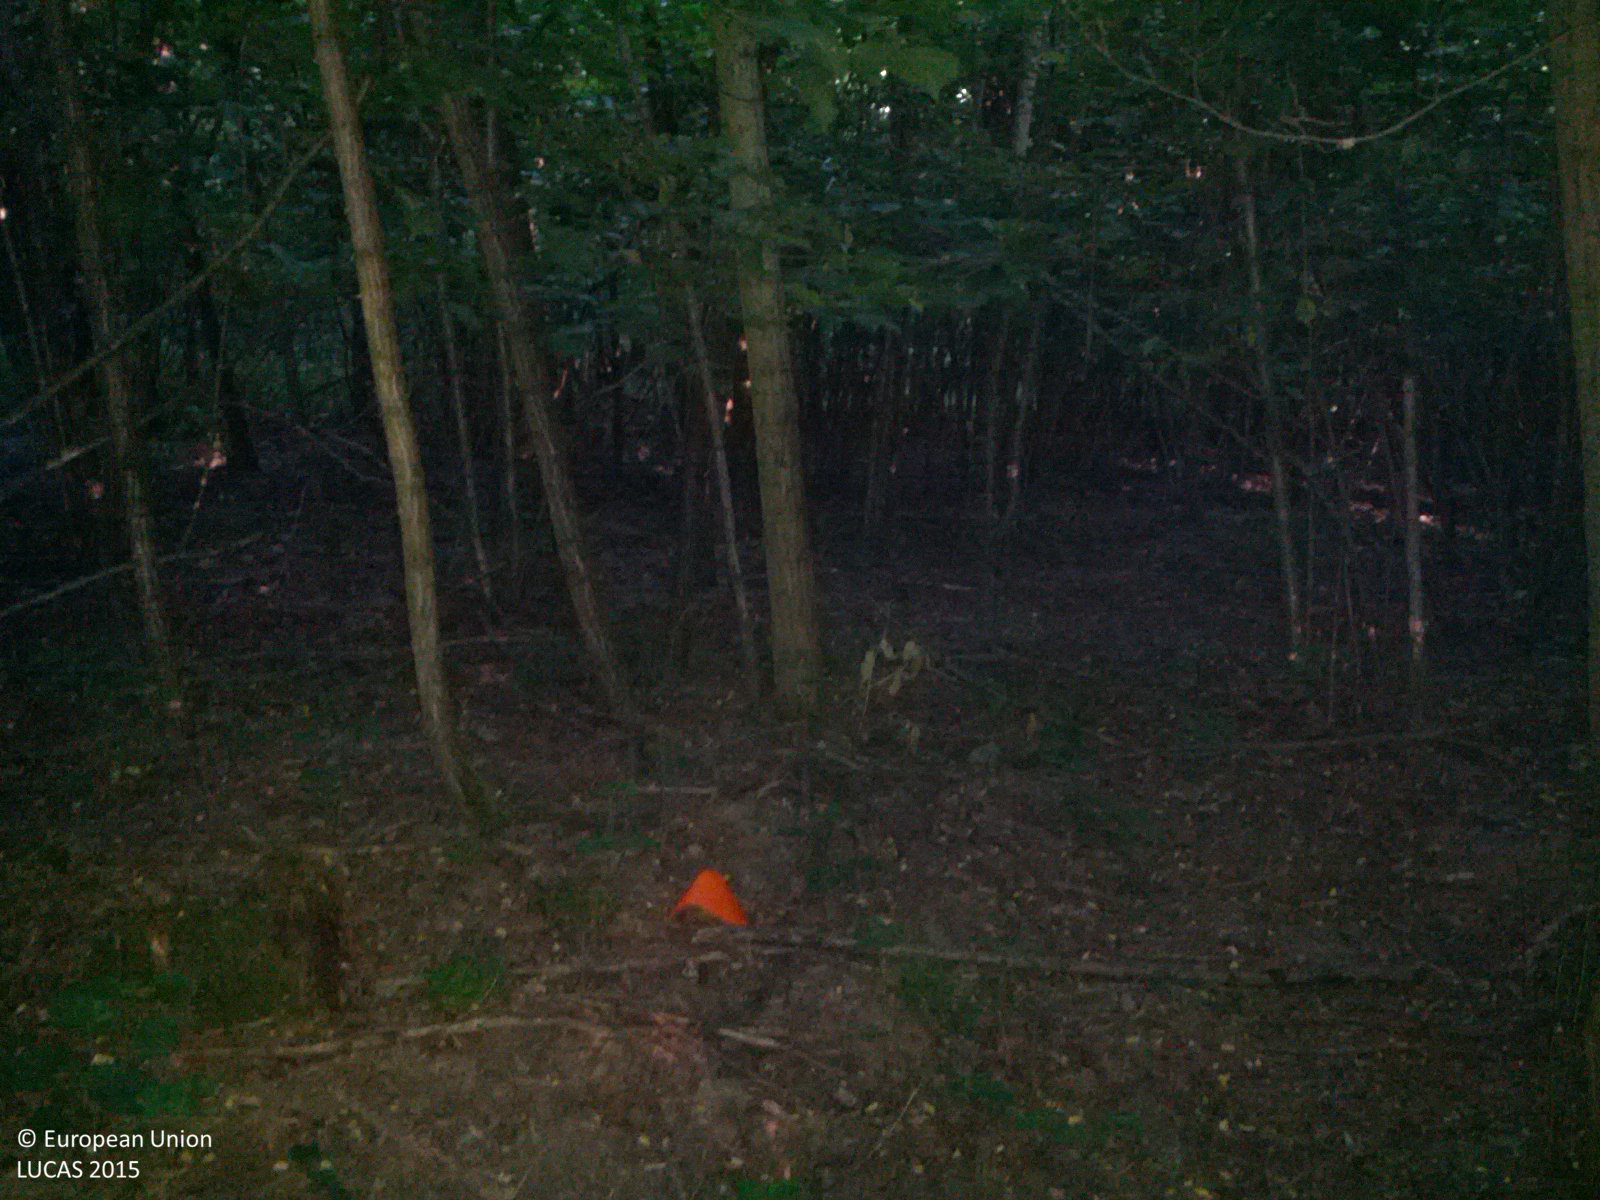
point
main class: Woodland
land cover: Broadleaved woodland
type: mesophytic deciduous forest
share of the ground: > 75 %
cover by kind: broadleaved forest trees 95 %, herbaceous plants 5 %
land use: Forestry
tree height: > 5 m
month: July
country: AT
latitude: 48.6402
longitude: 16.5886
